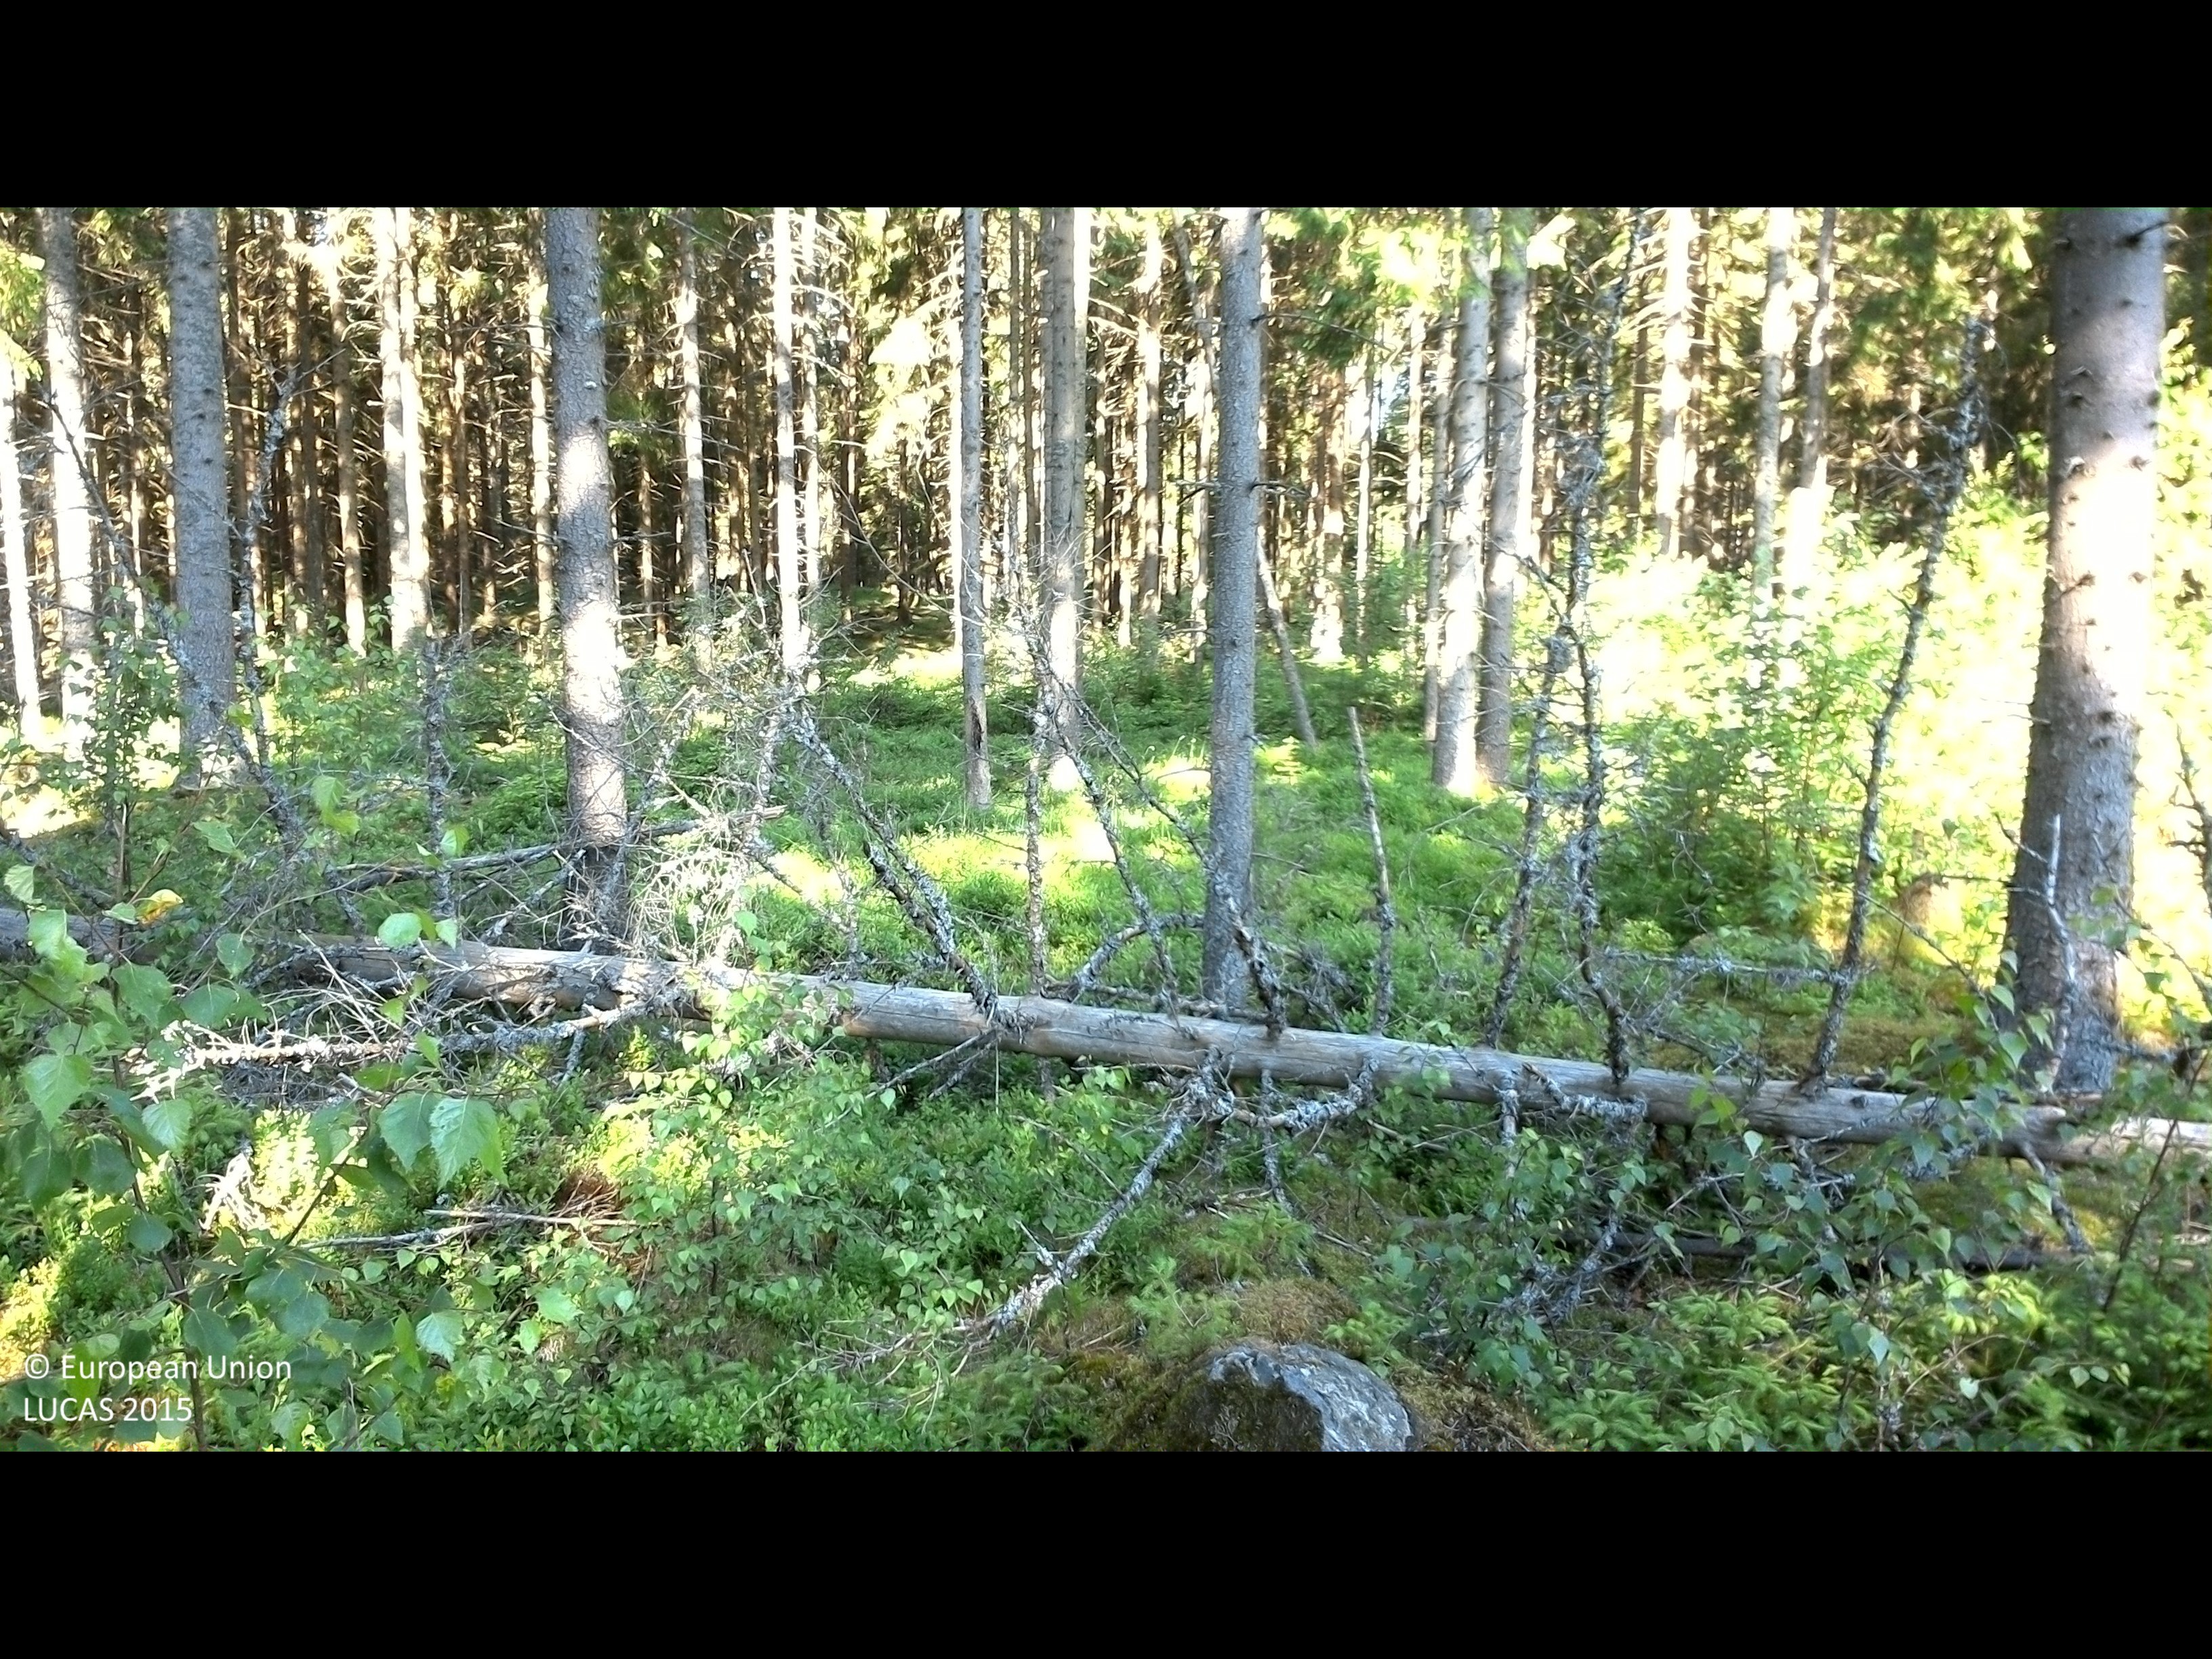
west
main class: Woodland
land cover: Spruce dominated coniferous woodland
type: boreal forest
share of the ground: 50 - 75 %
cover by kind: coniferous forest trees 60 %, shrubs 25 %, lichens and mosses 10 %, broadleaved forest trees 5 %
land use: Forestry
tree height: > 5 m
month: July
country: SE
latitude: 56.5318
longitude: 14.7616
